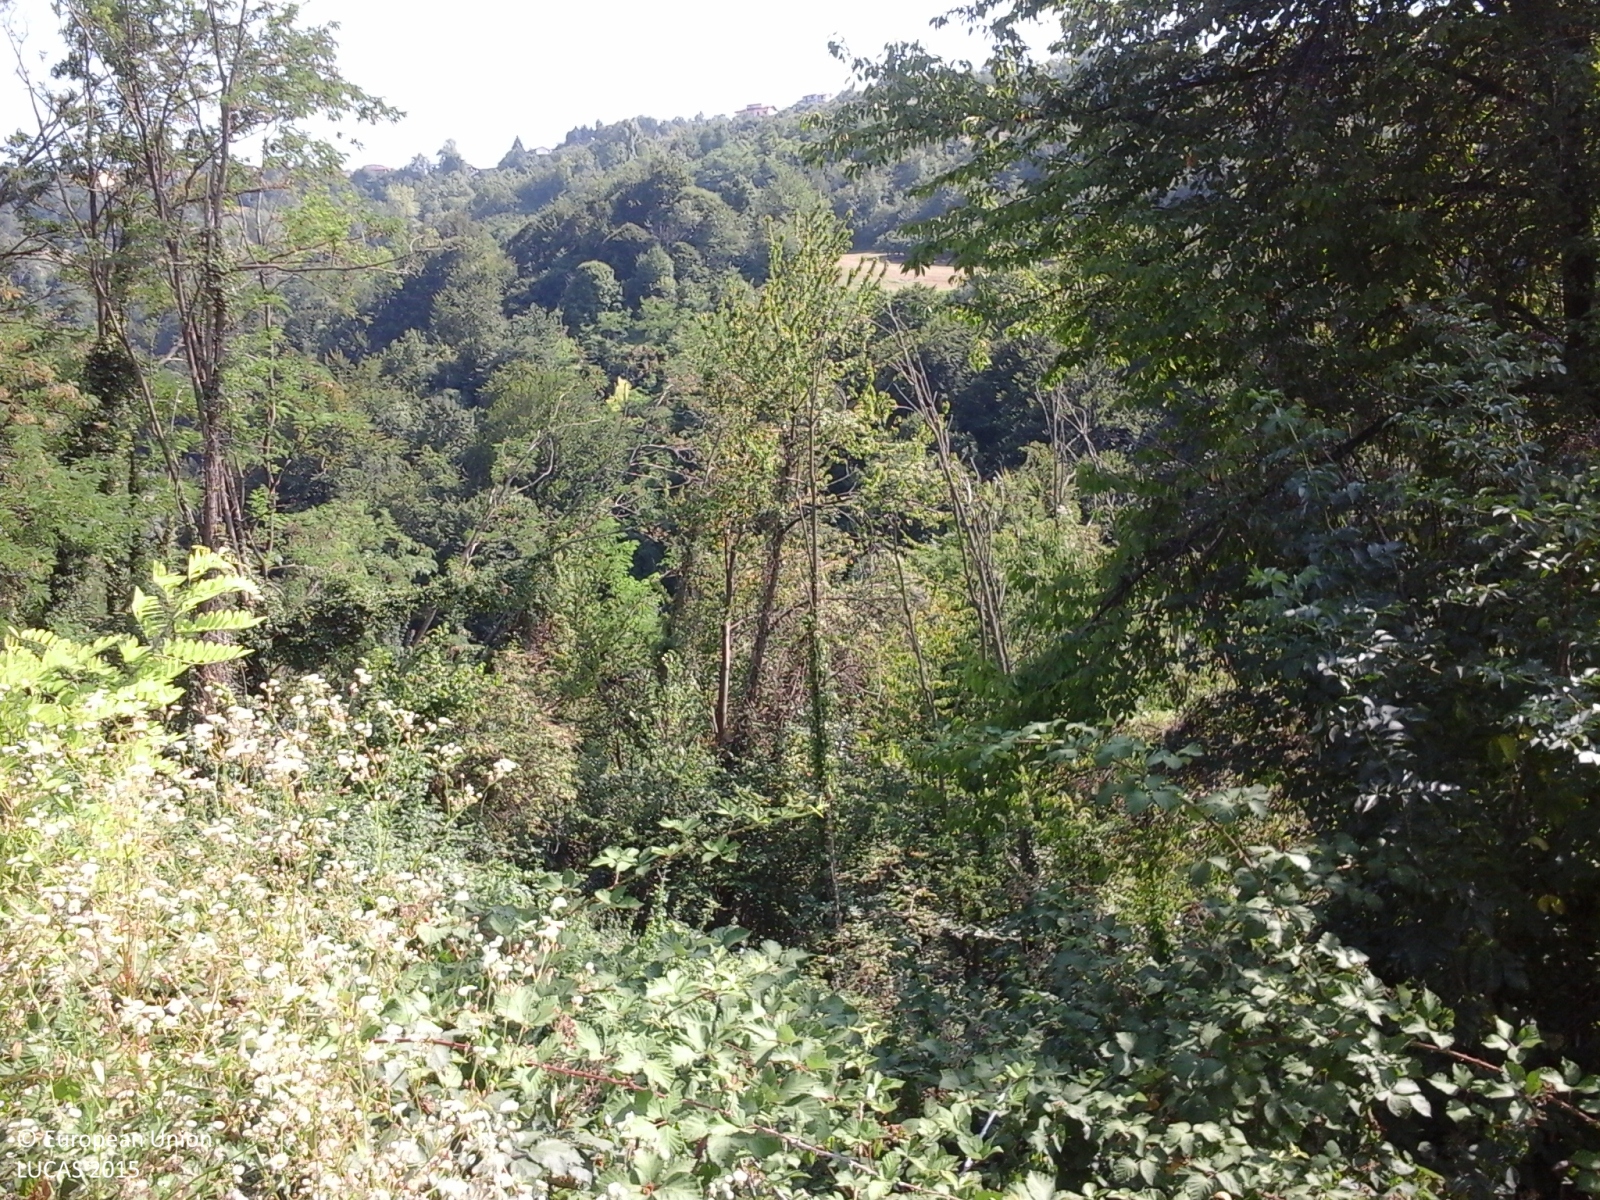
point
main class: Woodland
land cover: Broadleaved woodland
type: thermophilous deciduous forest
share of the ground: > 75 %
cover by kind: broadleaved forest trees 90 %, shrubs 5 %, herbaceous plants 5 %
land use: Forestry
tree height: > 5 m
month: July
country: IT
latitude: 44.6398
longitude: 8.1002
